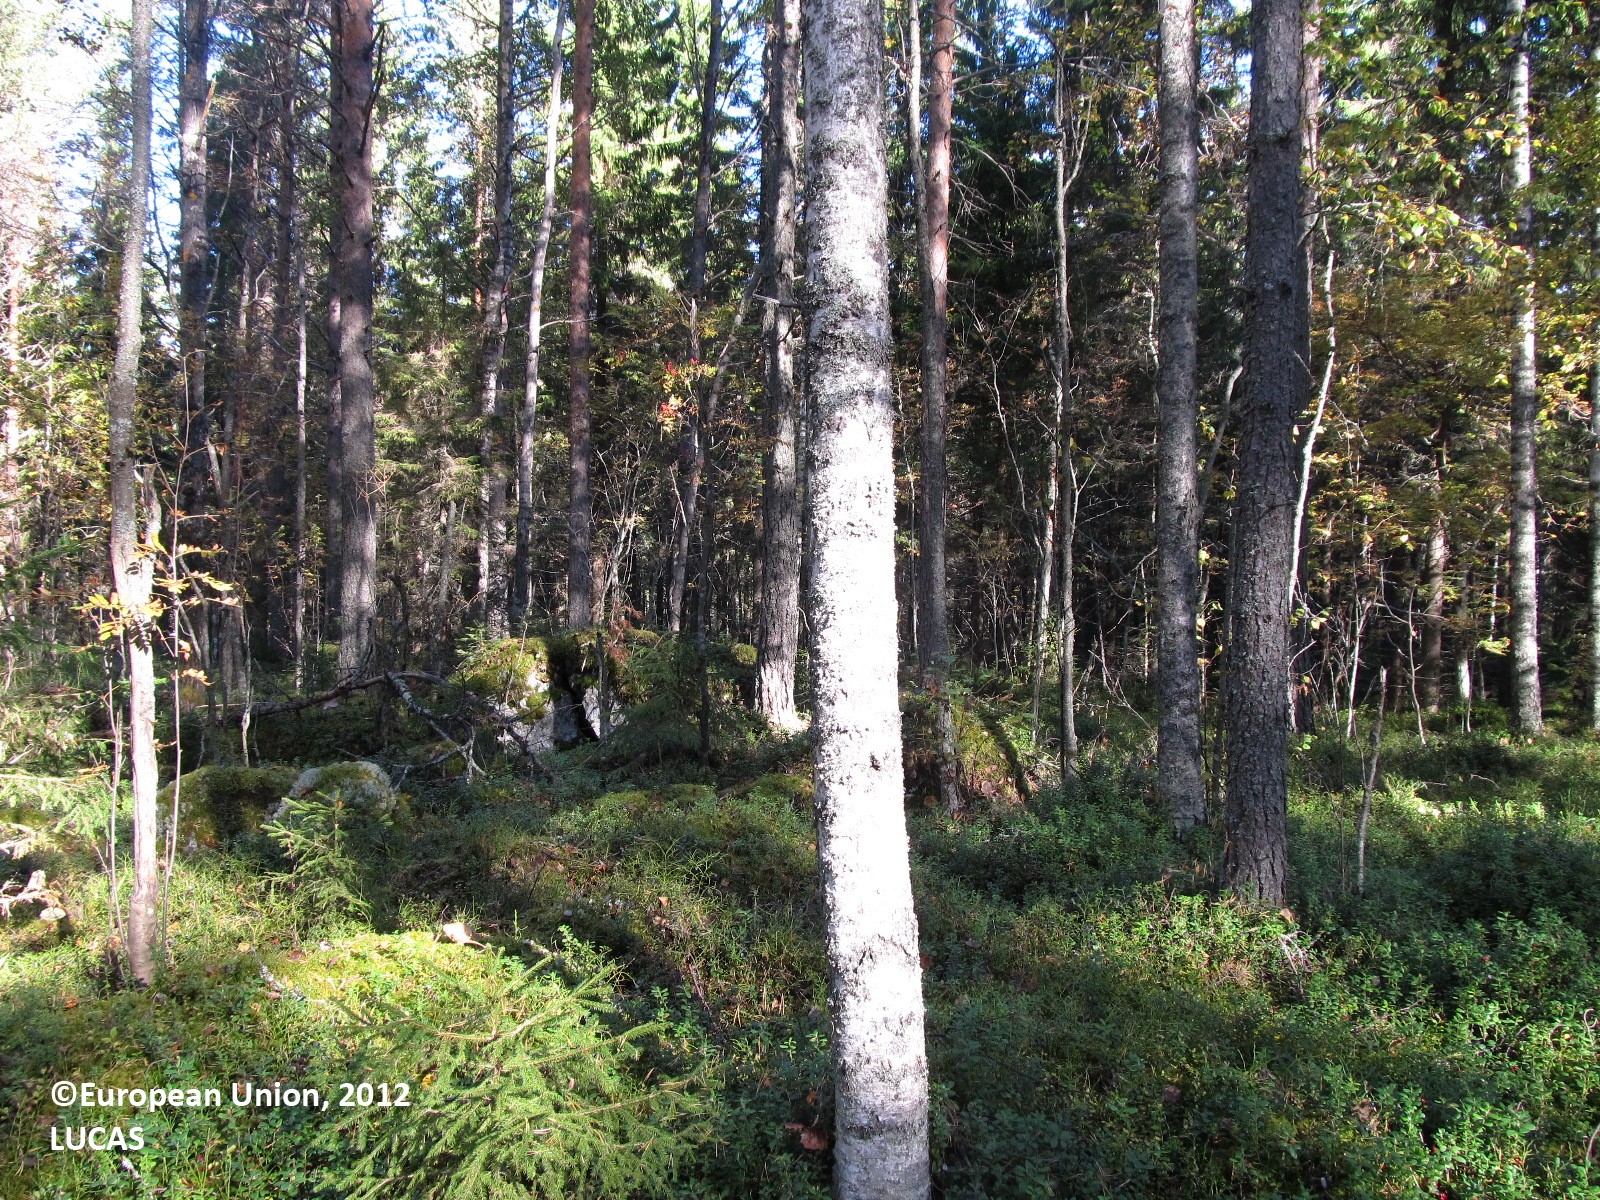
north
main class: Woodland
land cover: Pine dominated coniferous woodland
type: boreal forest
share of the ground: 25 - 50 %
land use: Forestry
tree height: > 5 m
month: September
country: FI
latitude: 62.4897
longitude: 28.2194
